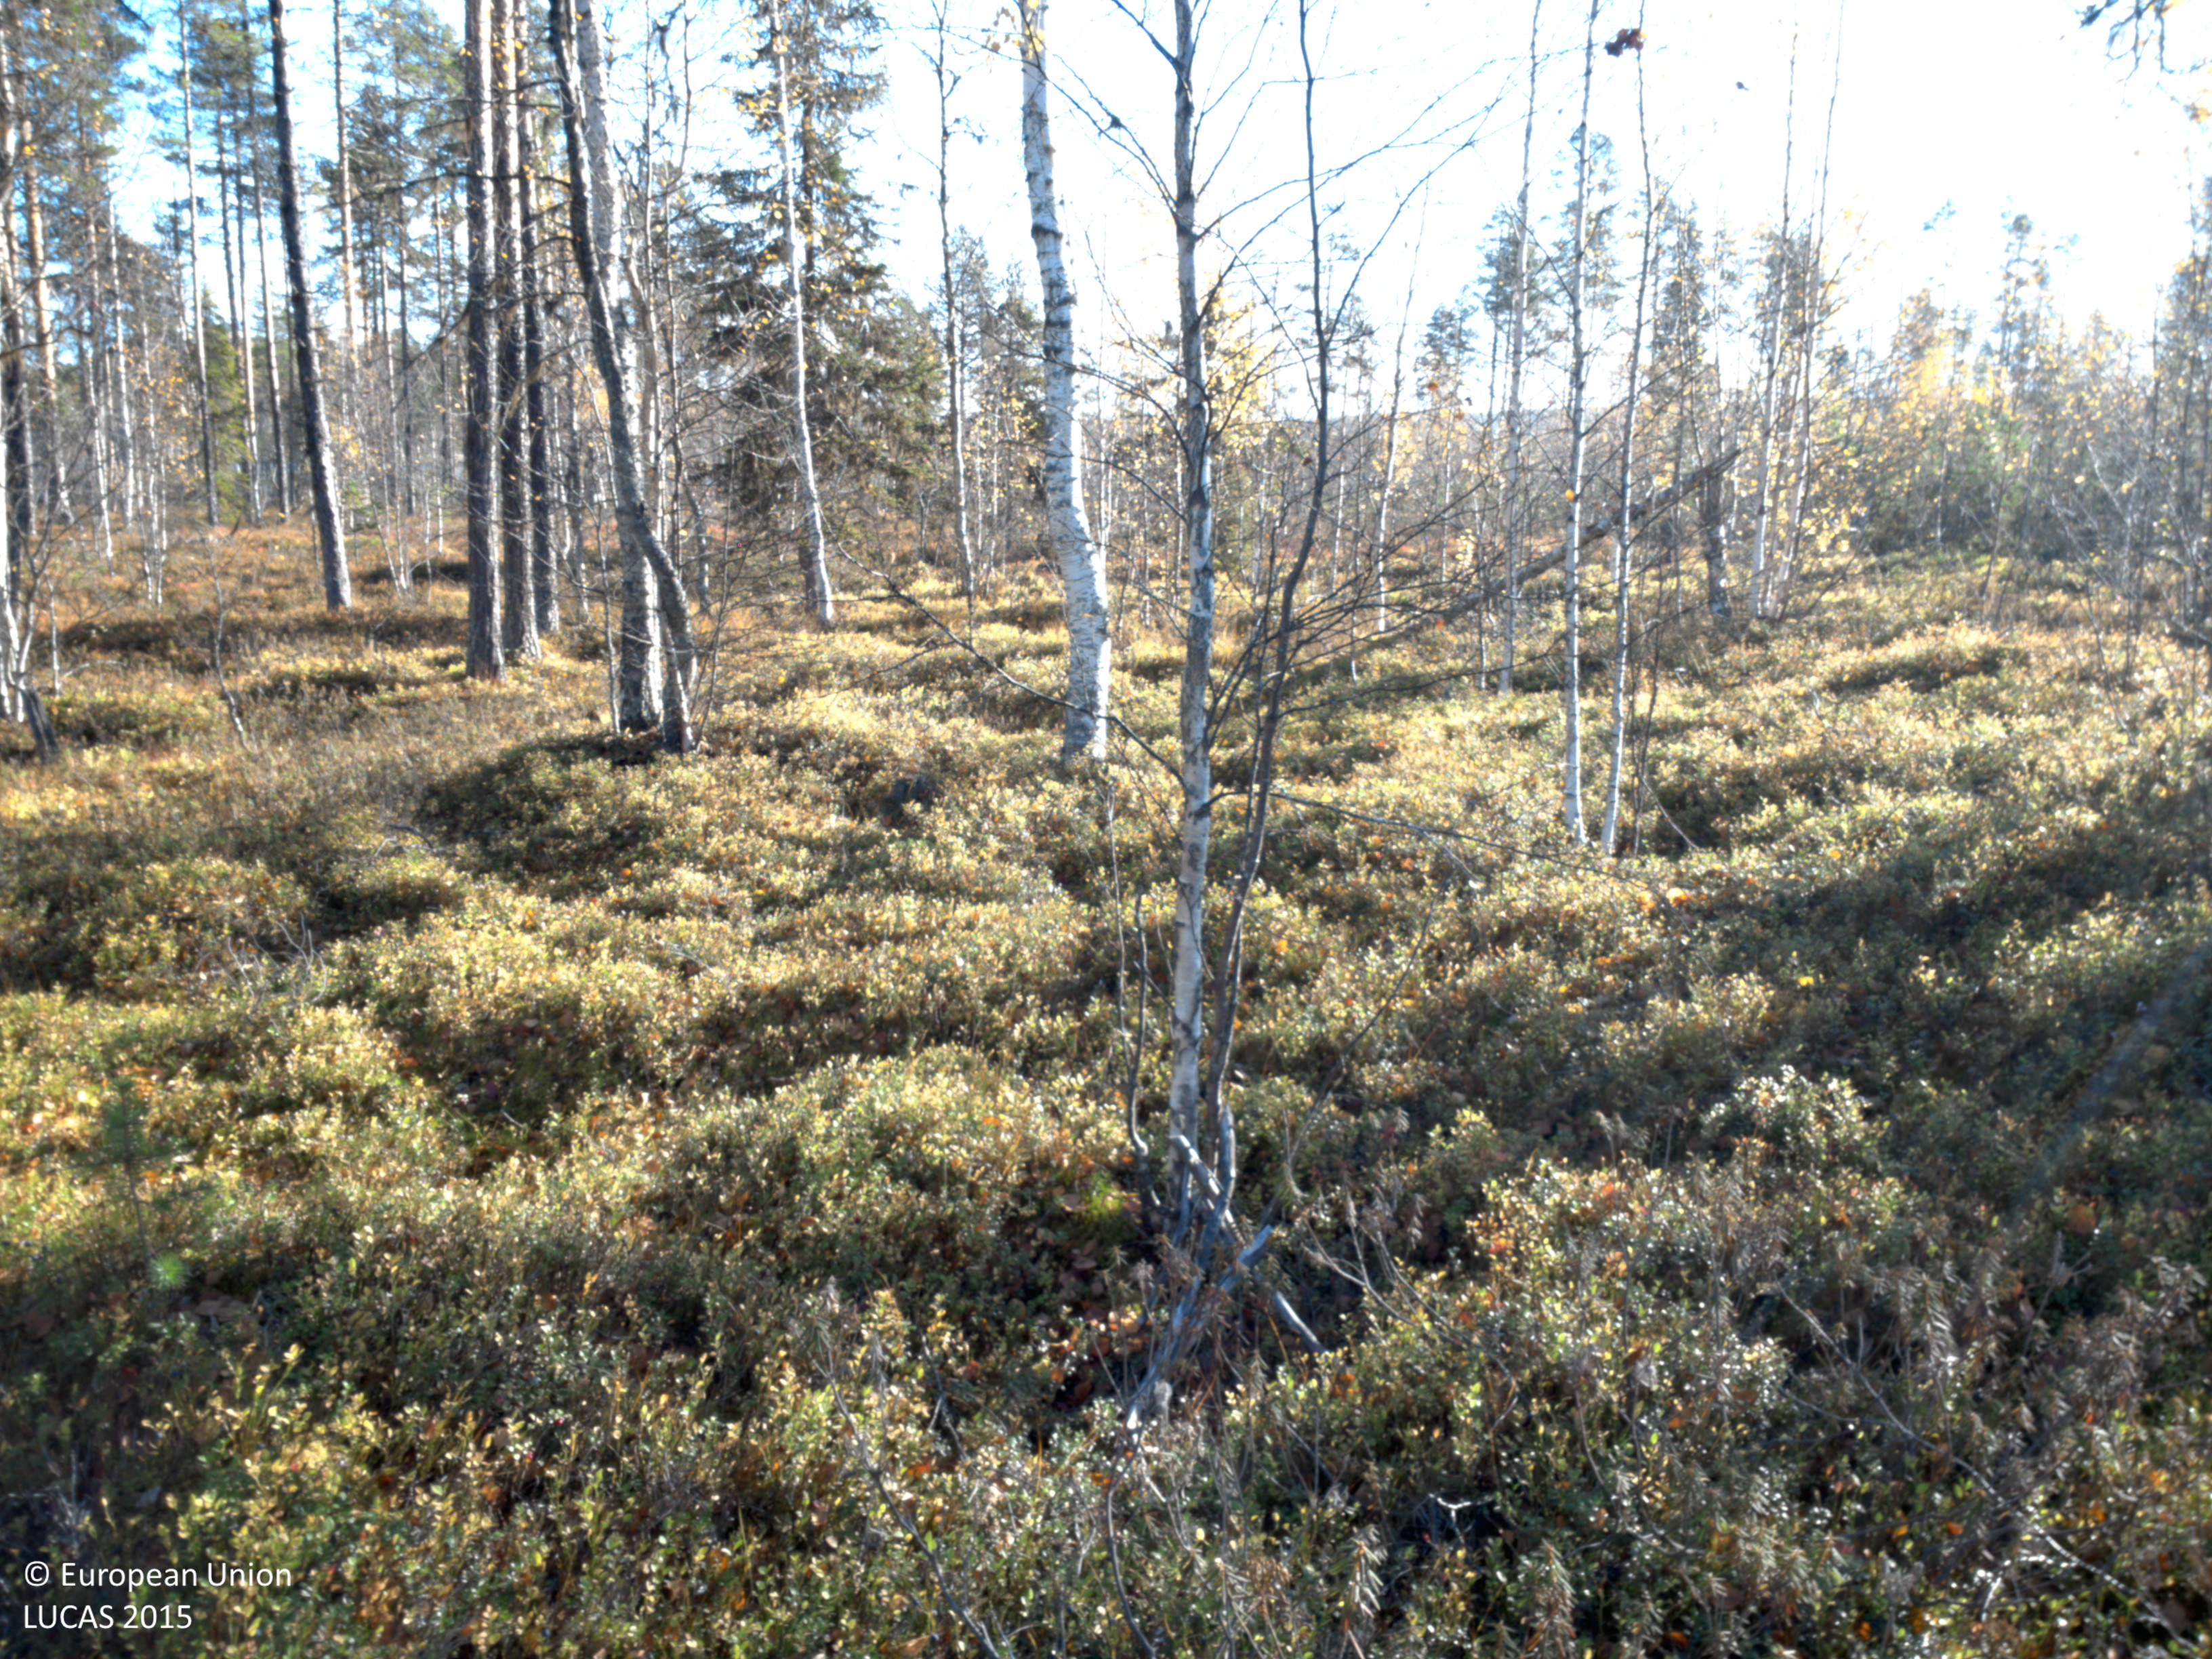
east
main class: Woodland
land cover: Broadleaved woodland
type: hemiboreal forest and nemoral coniferous forest and mixed broadleaved-coniferous forest
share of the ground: 50 - 75 %
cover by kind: broadleaved forest trees 50 %, shrubs 40 %, coniferous forest trees 5 %, lichens and mosses 5 %
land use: Forestry
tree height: > 5 m
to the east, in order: Broadleaved woodland; Spruce dominated mixed woodland; Pine dominated mixed woodland; Ditches and canals; Paved roads, cycling and walking lanes; Ditches and canals; Pine dominated mixed woodland; Electric lines; Pine dominated mixed woodland; Inland fresh water bodies
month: September
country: SE
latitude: 64.8405
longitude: 18.5457
